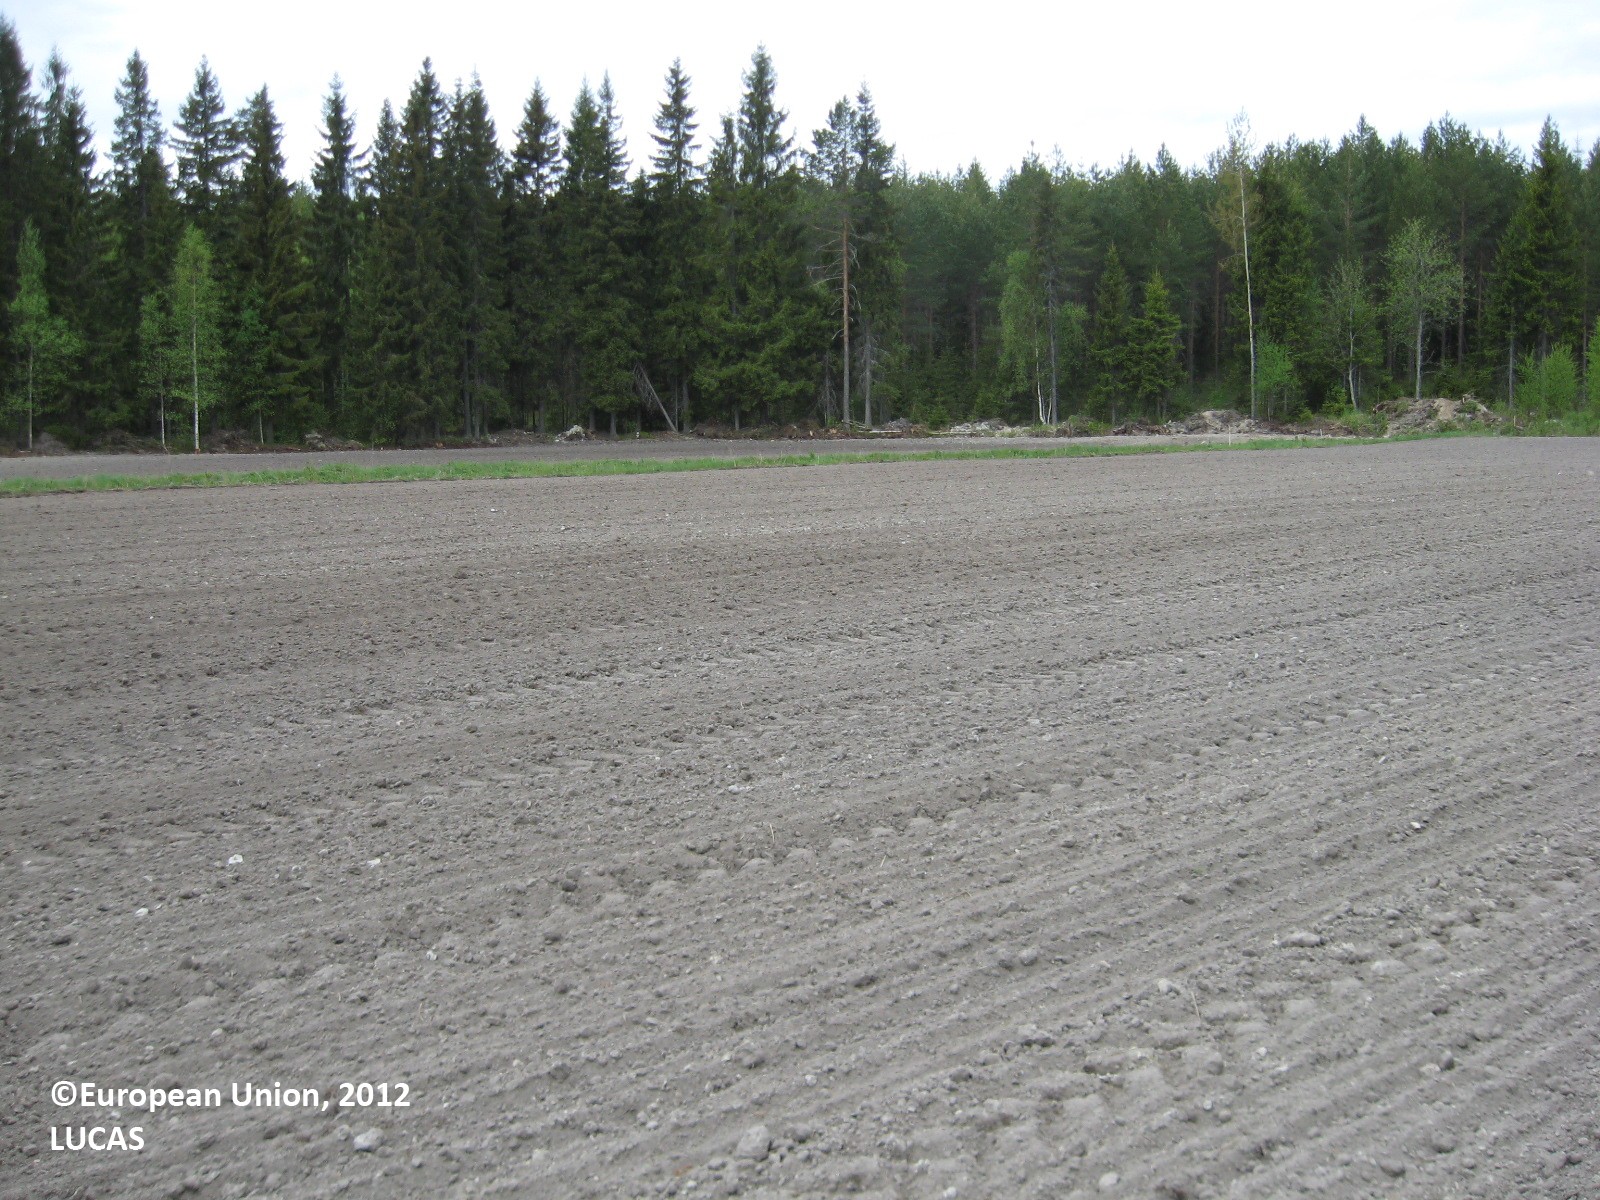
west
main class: Cropland
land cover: Oats
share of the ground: < 10 %
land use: Agriculture (excluding fallow land and kitchen gardens)
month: May
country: FI
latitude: 61.8040
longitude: 22.8343
